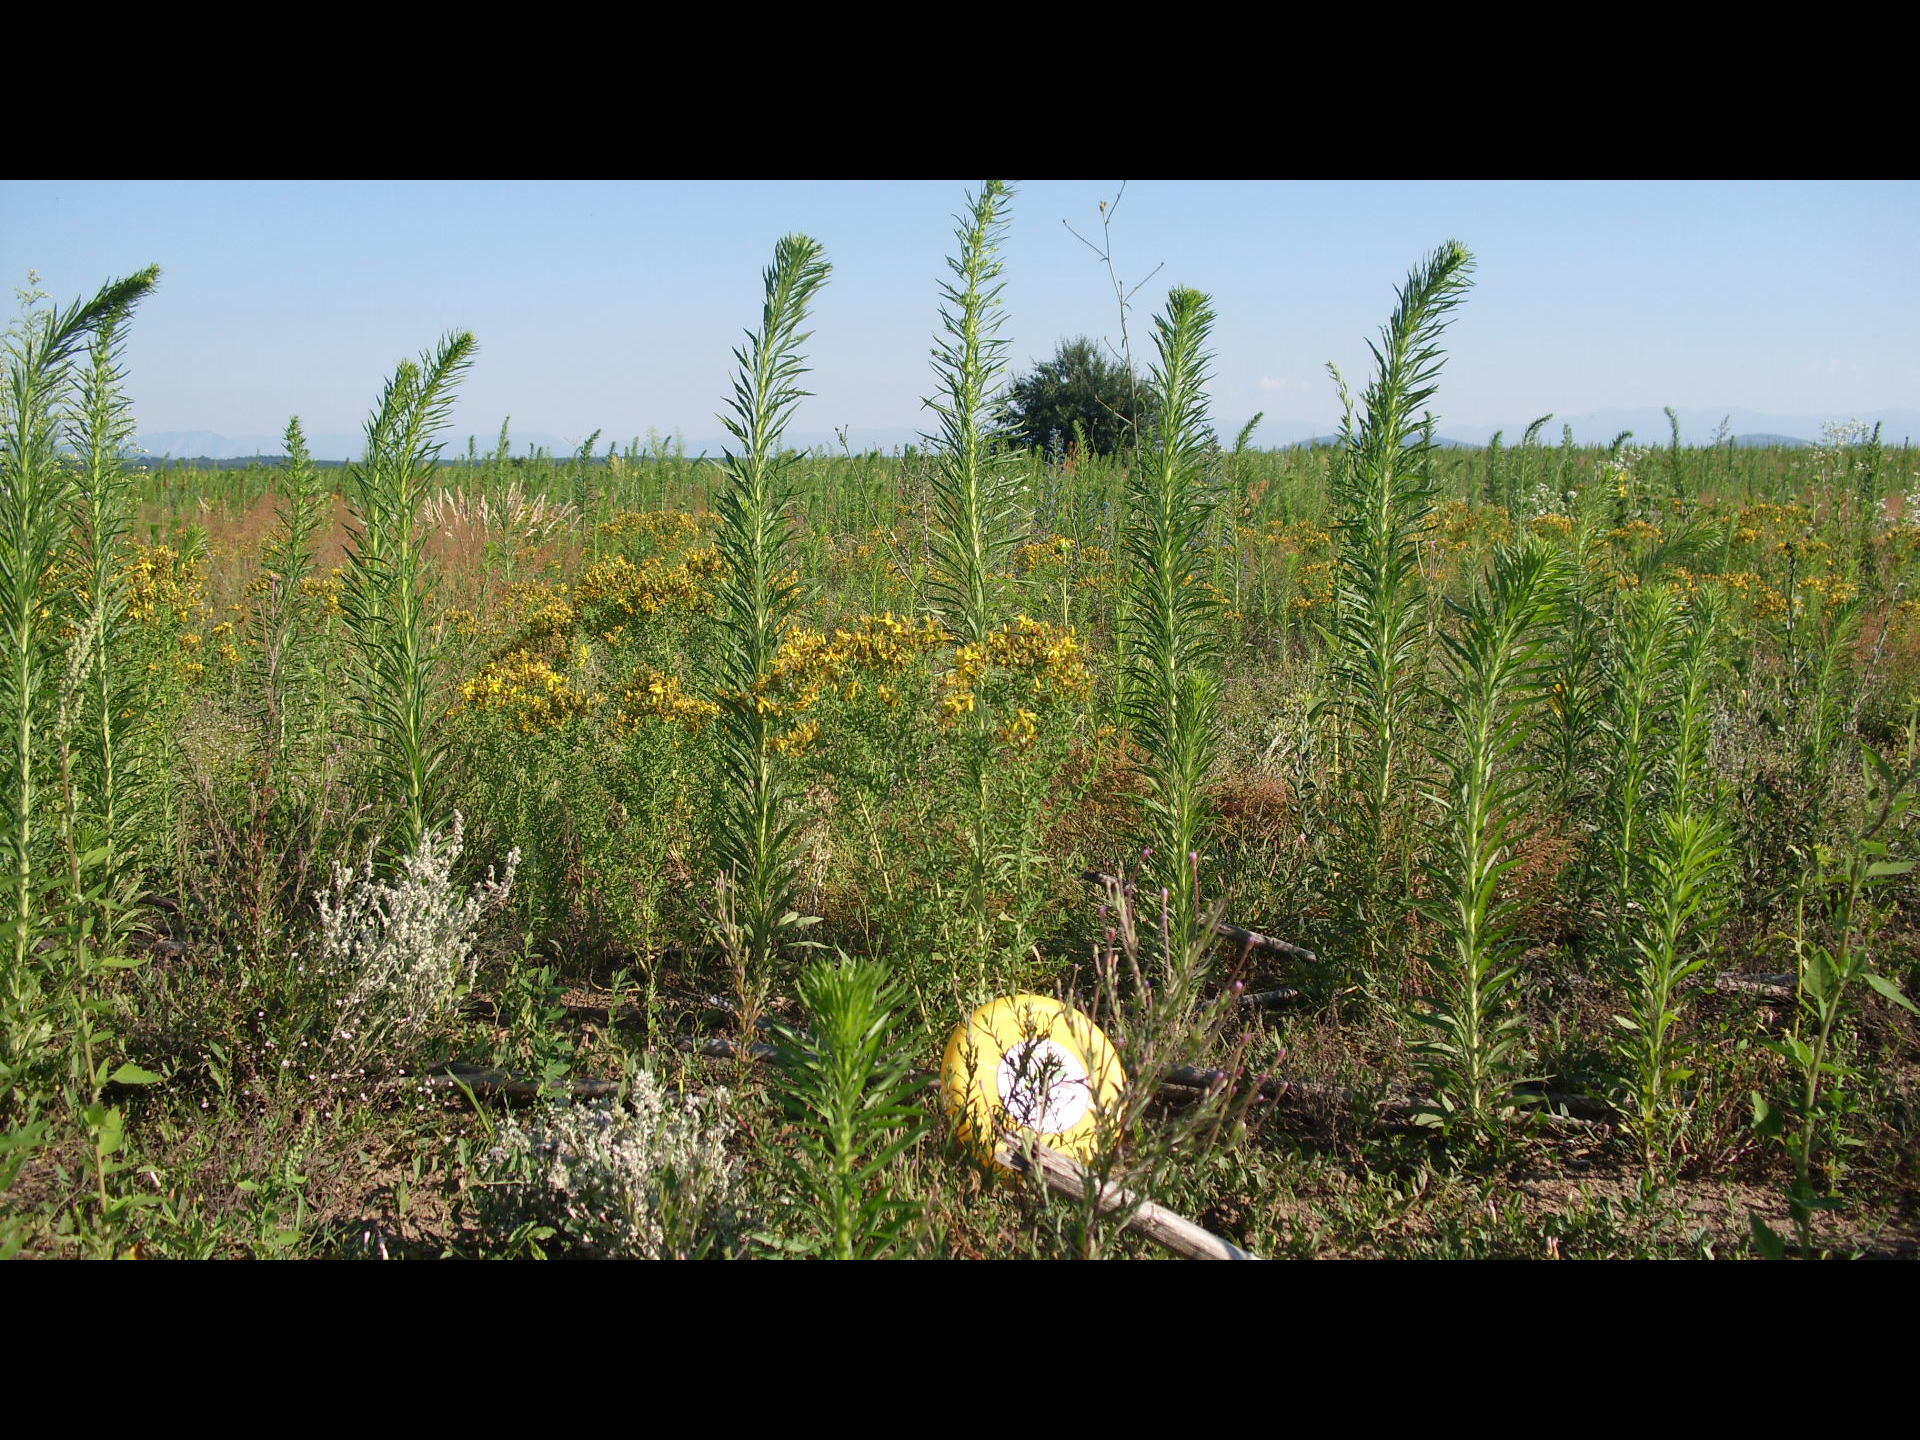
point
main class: Grassland
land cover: Spontaneously vegetated surfaces
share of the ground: > 75 %
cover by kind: herbaceous plants 85 %, unconsolidated bare surface 15 %
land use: Fallow land
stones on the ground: < 10 %
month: June
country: BG
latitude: 43.5642
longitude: 23.1510
